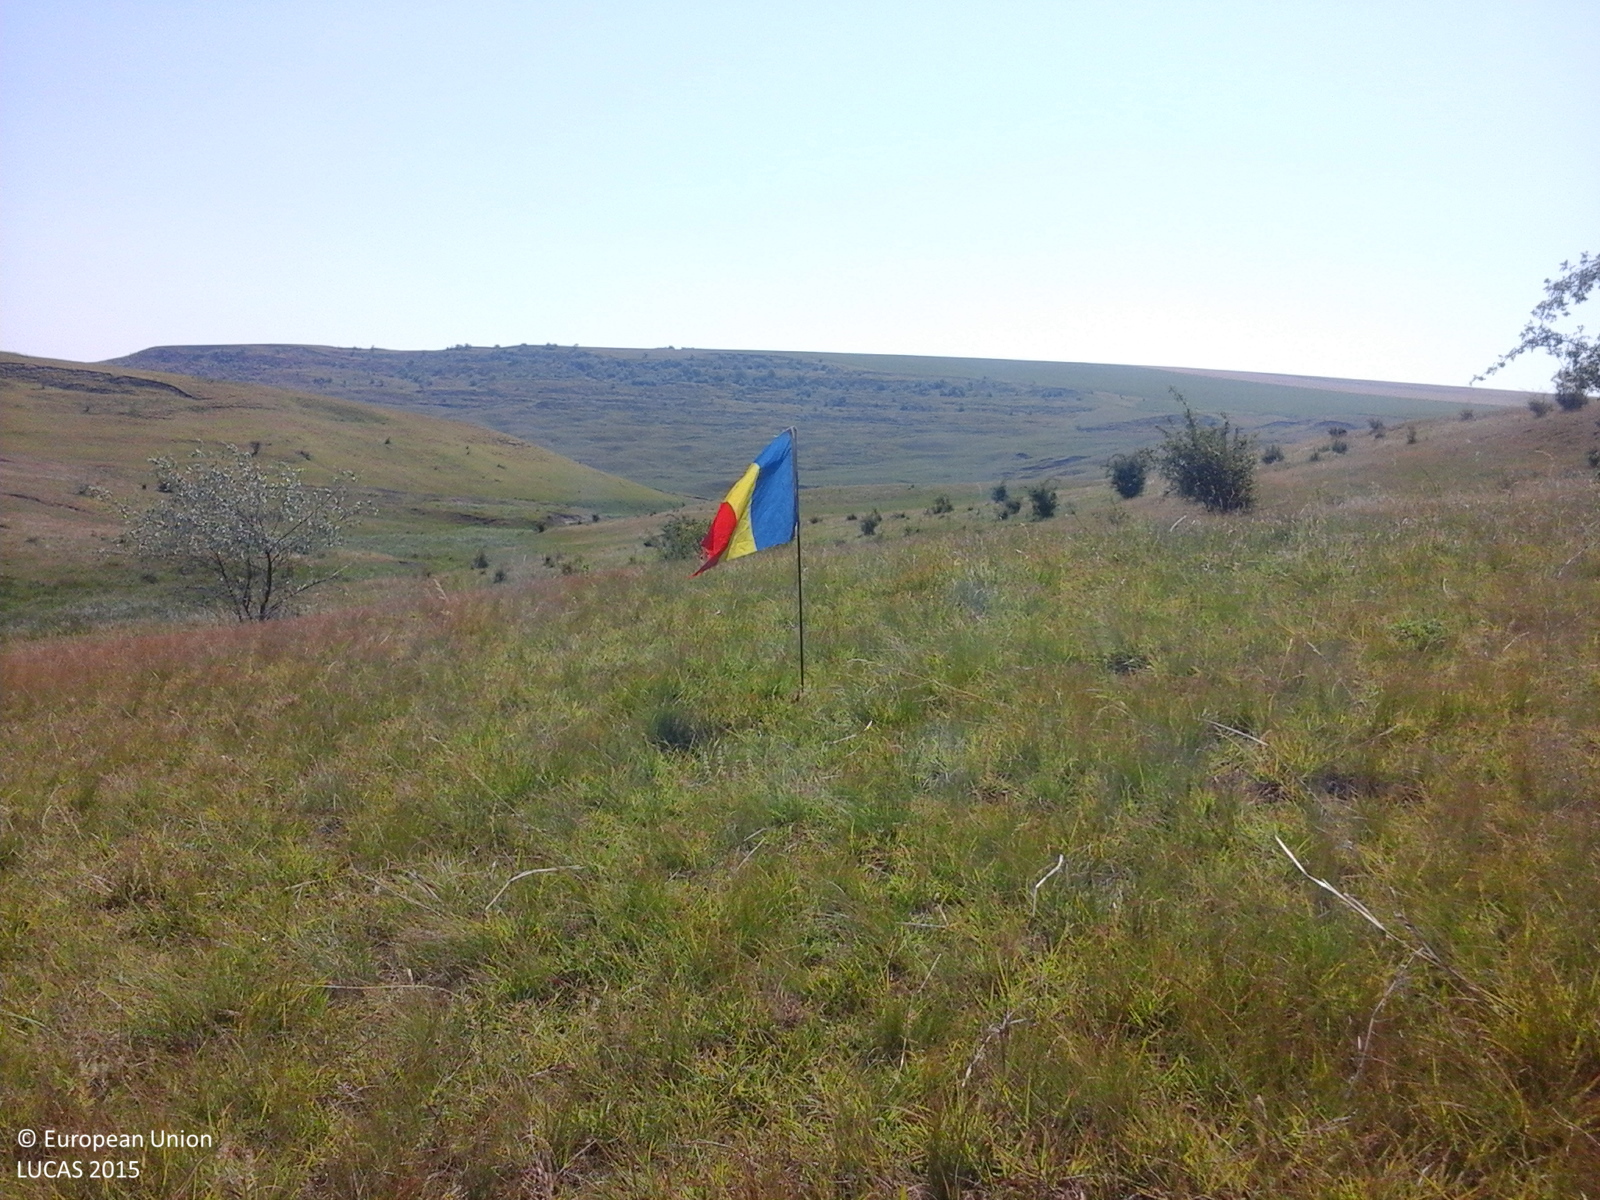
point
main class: Grassland
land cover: Grassland with sparse tree/shrub cover
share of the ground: > 75 %
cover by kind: herbaceous plants 85 %, shrubs 10 %, broadleaved forest trees 5 %
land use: Agriculture (excluding fallow land and kitchen gardens)
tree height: < 5 m
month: June
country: RO
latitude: 47.6854
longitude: 27.2026
